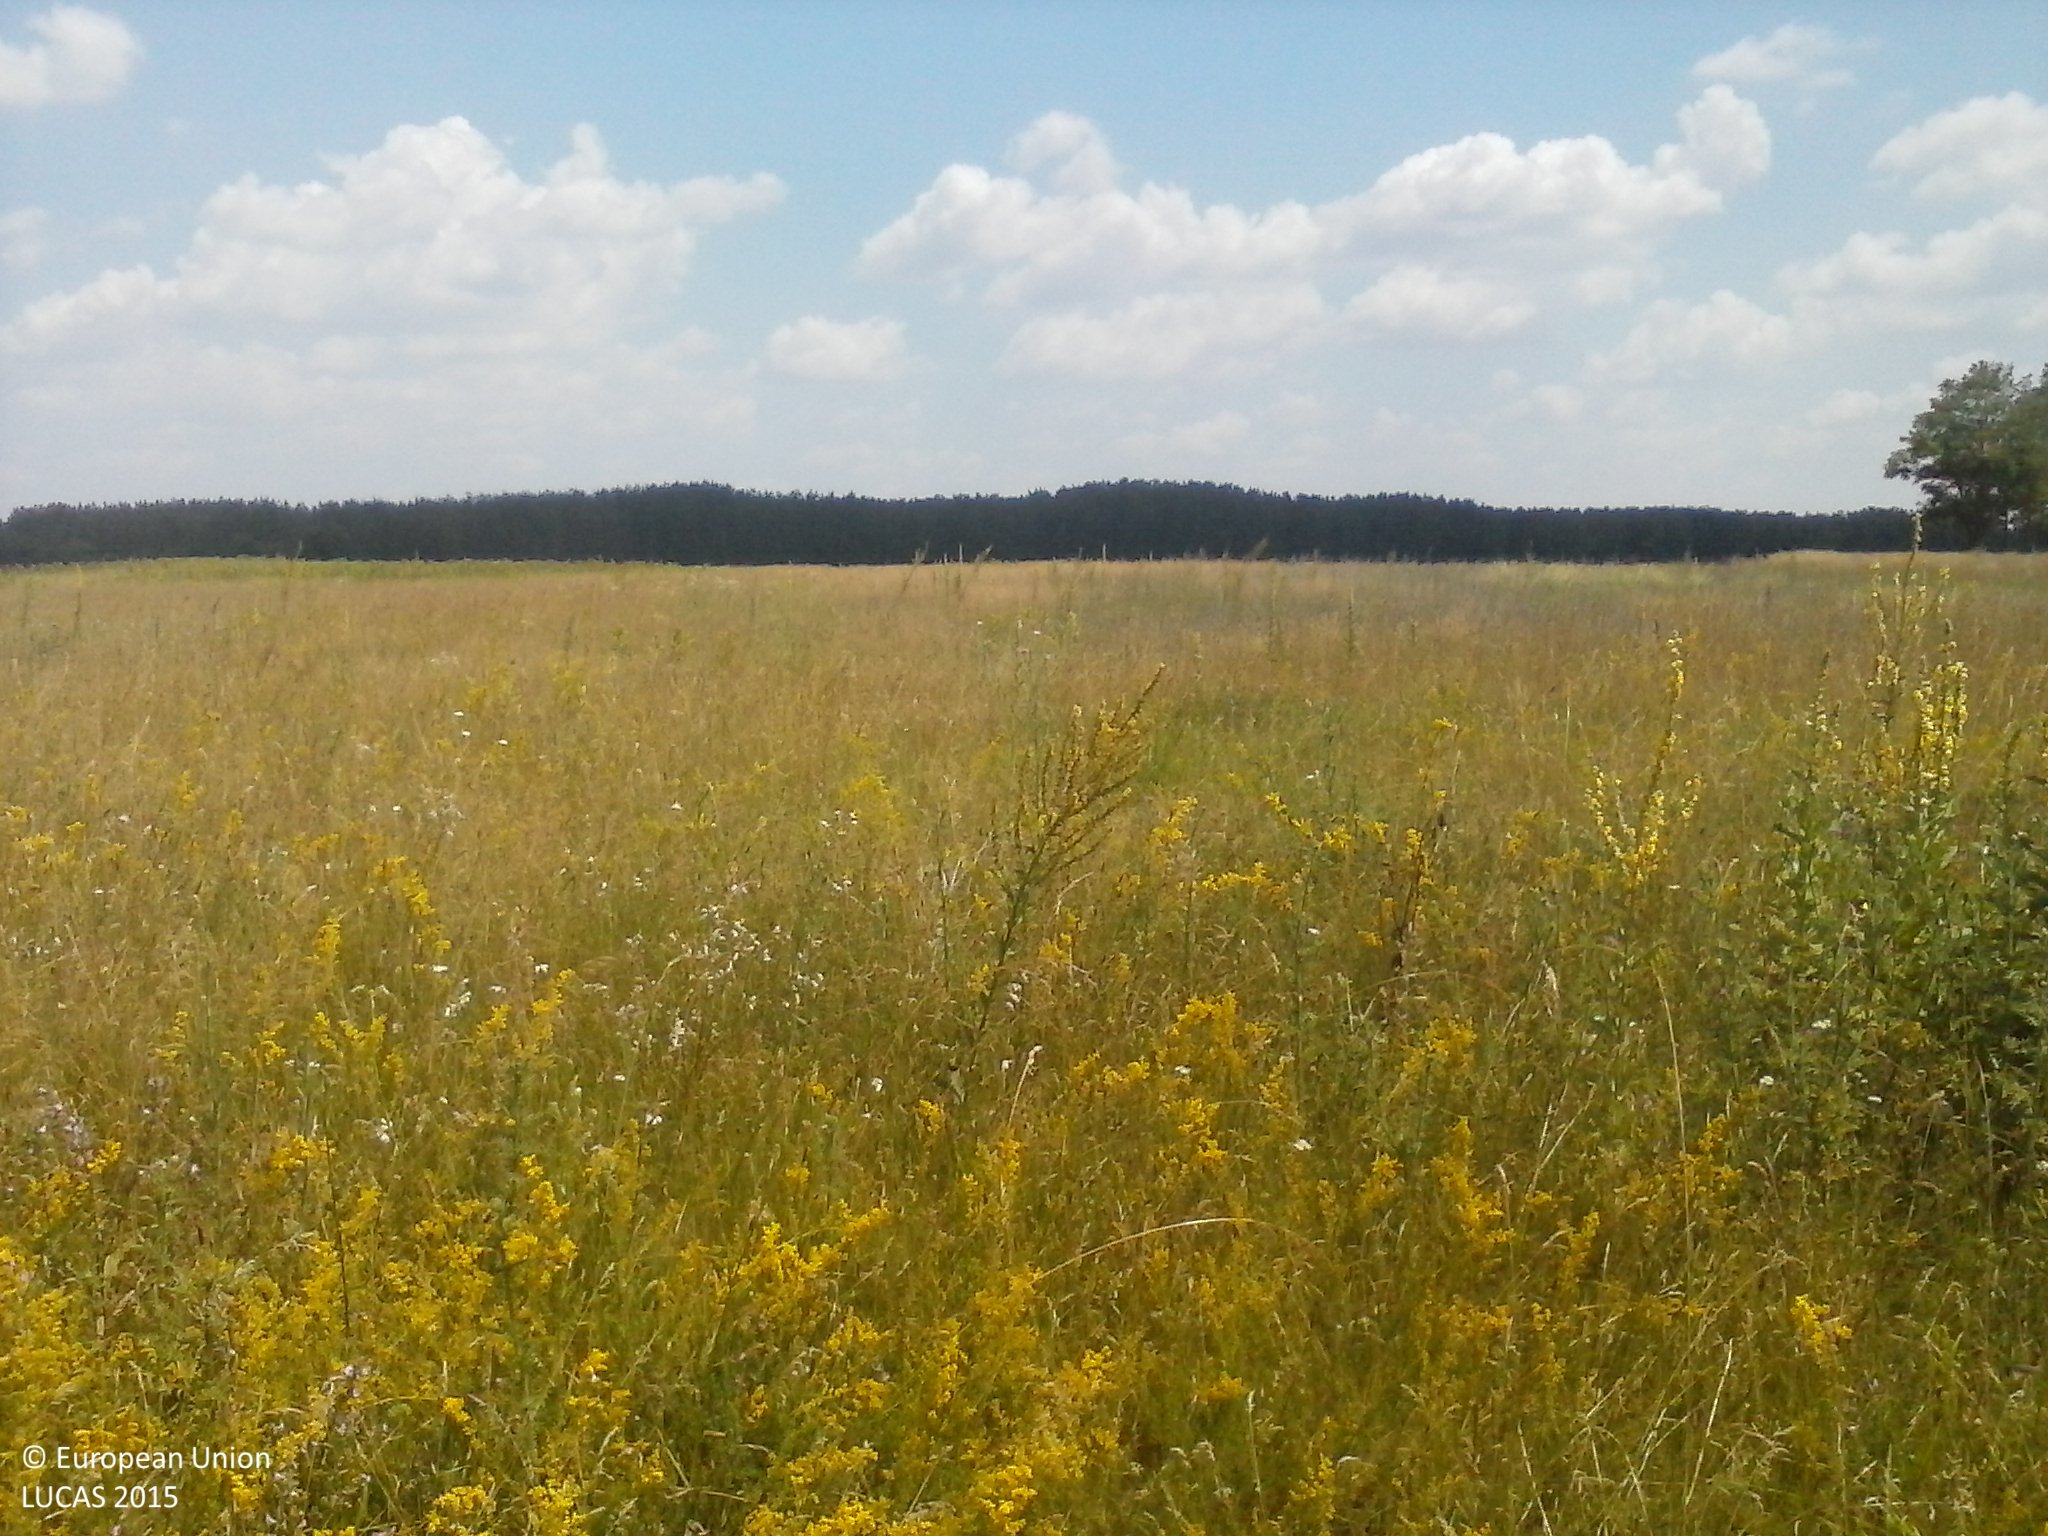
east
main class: Grassland
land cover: Grassland without tree/shrub cover
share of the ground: > 75 %
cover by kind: herbaceous plants 100 %
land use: Agriculture (excluding fallow land and kitchen gardens)
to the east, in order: Grassland without tree/shrub cover
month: July
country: HU
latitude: 46.3230
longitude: 19.5373
